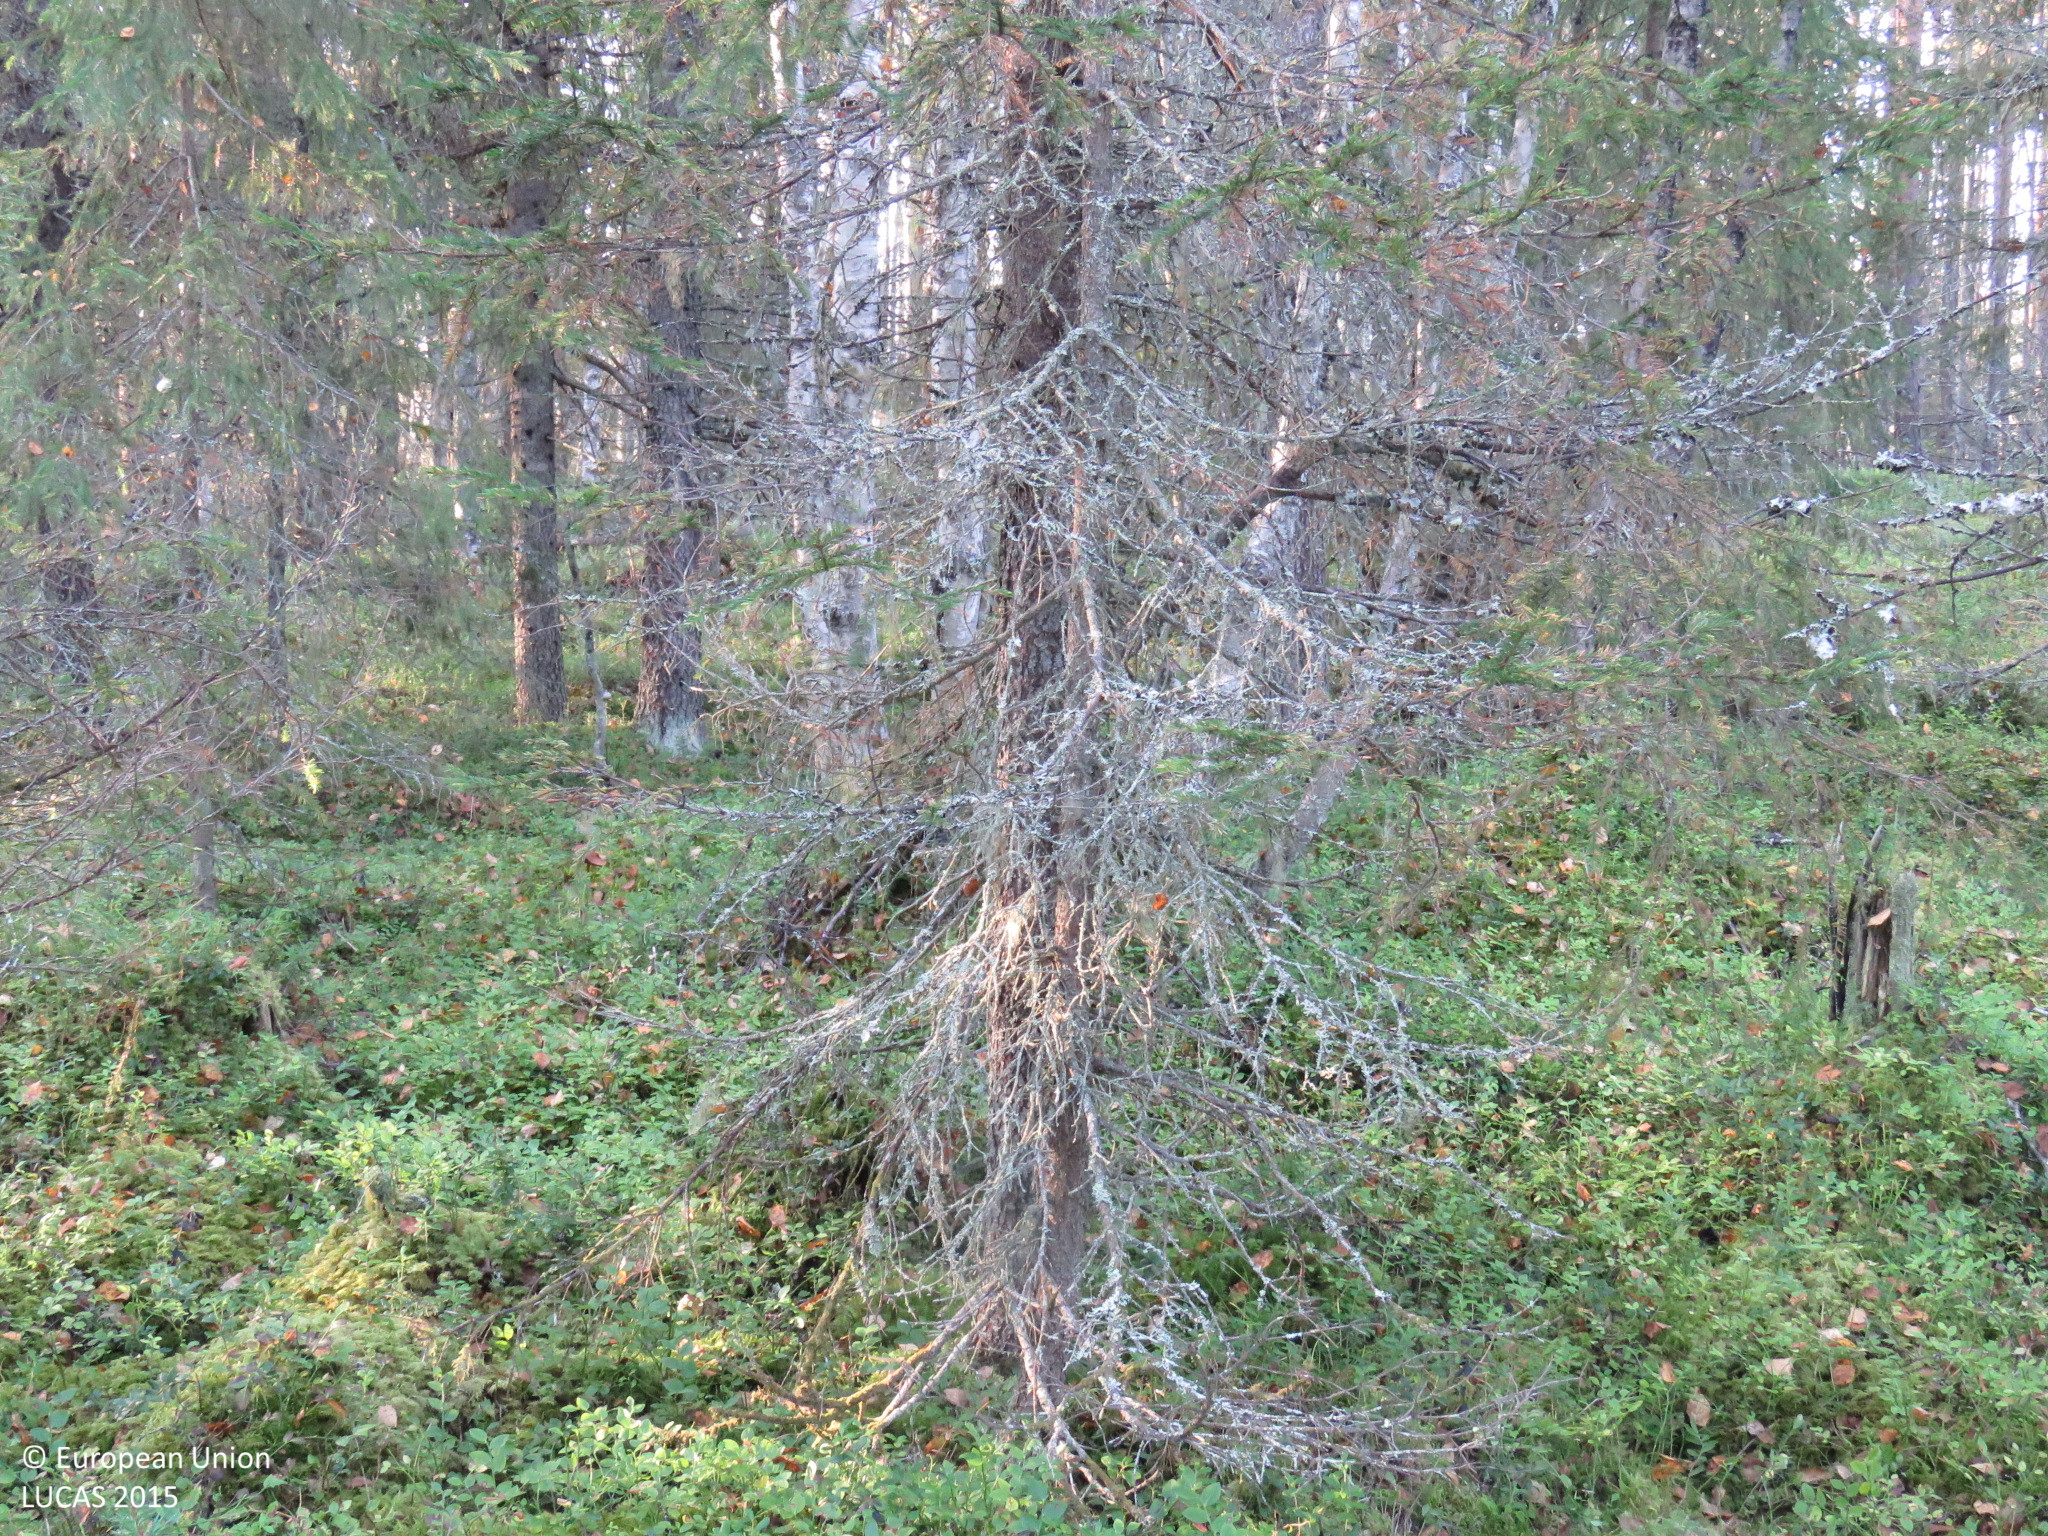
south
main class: Woodland
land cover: Spruce dominated mixed woodland
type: boreal forest
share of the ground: > 75 %
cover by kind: coniferous forest trees 60 %, broadleaved forest trees 20 %, shrubs 15 %, lichens and mosses 5 %
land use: Forestry
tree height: > 5 m
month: September
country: FI
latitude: 64.9172
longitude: 26.4935
